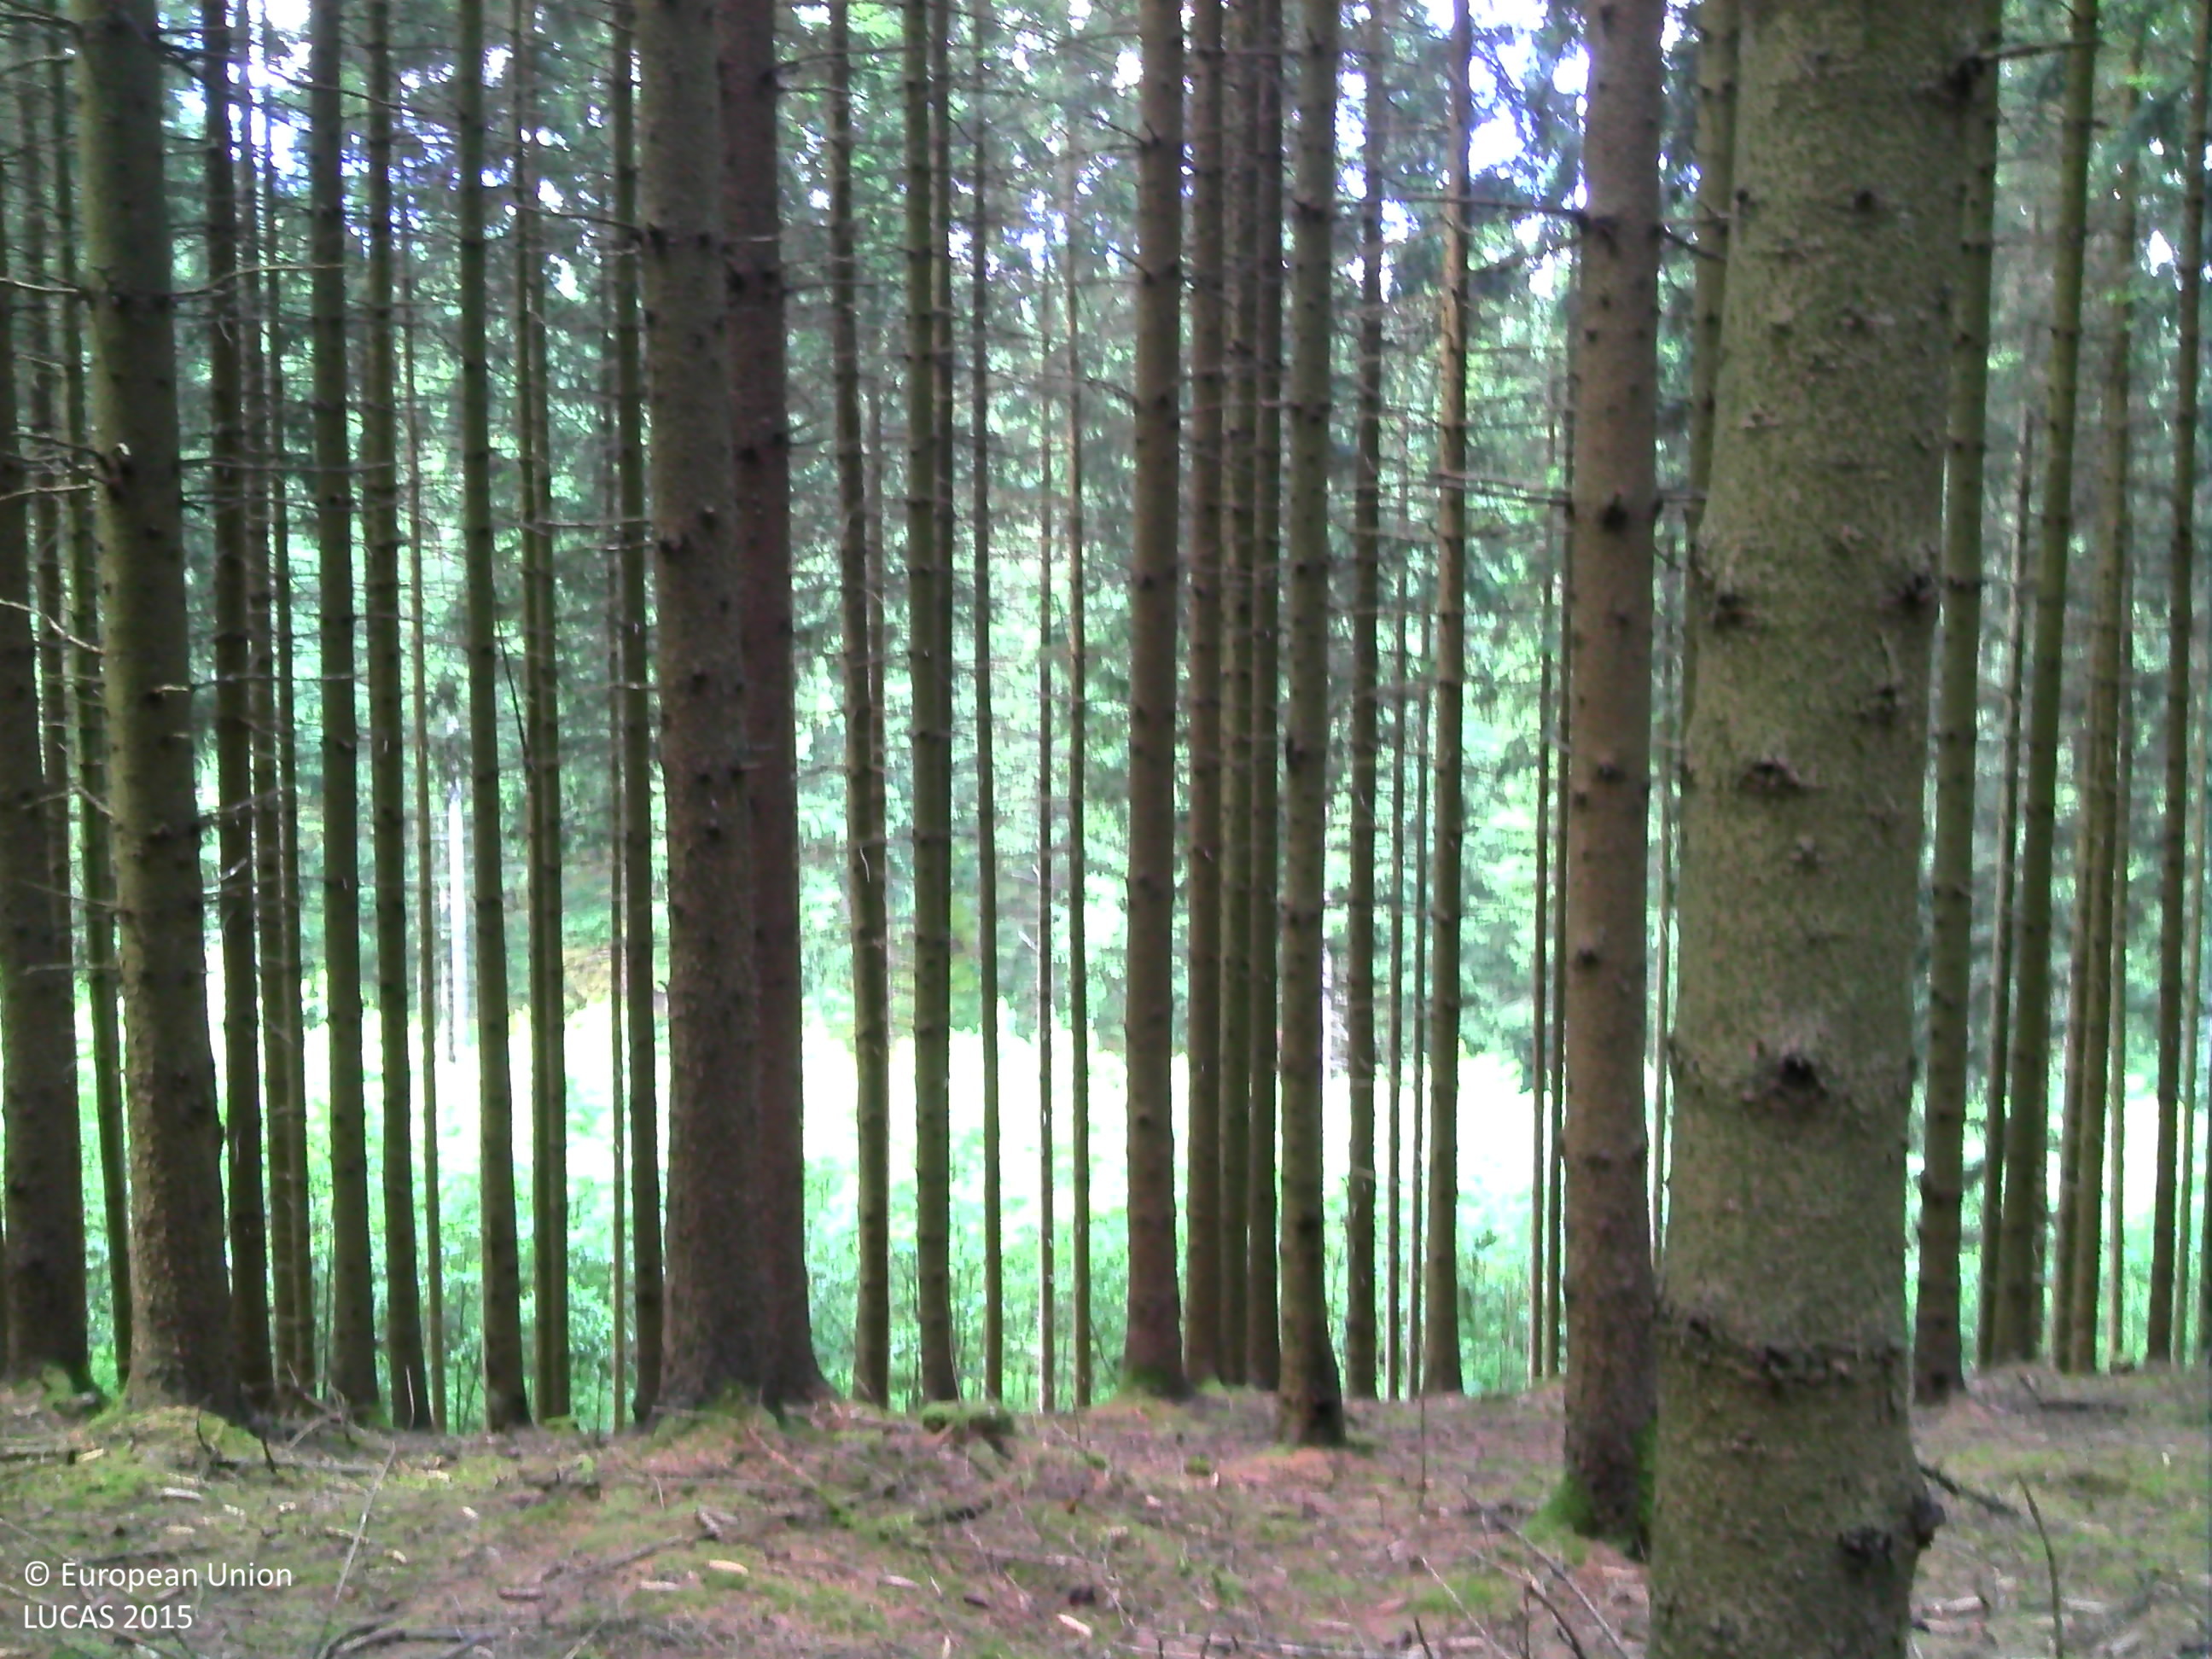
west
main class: Woodland
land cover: Spruce dominated coniferous woodland
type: exotic forest
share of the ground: > 75 %
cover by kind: coniferous forest trees 90 %, lichens and mosses 10 %
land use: Forestry
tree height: > 5 m
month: July
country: BE
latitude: 50.2856
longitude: 6.2802
